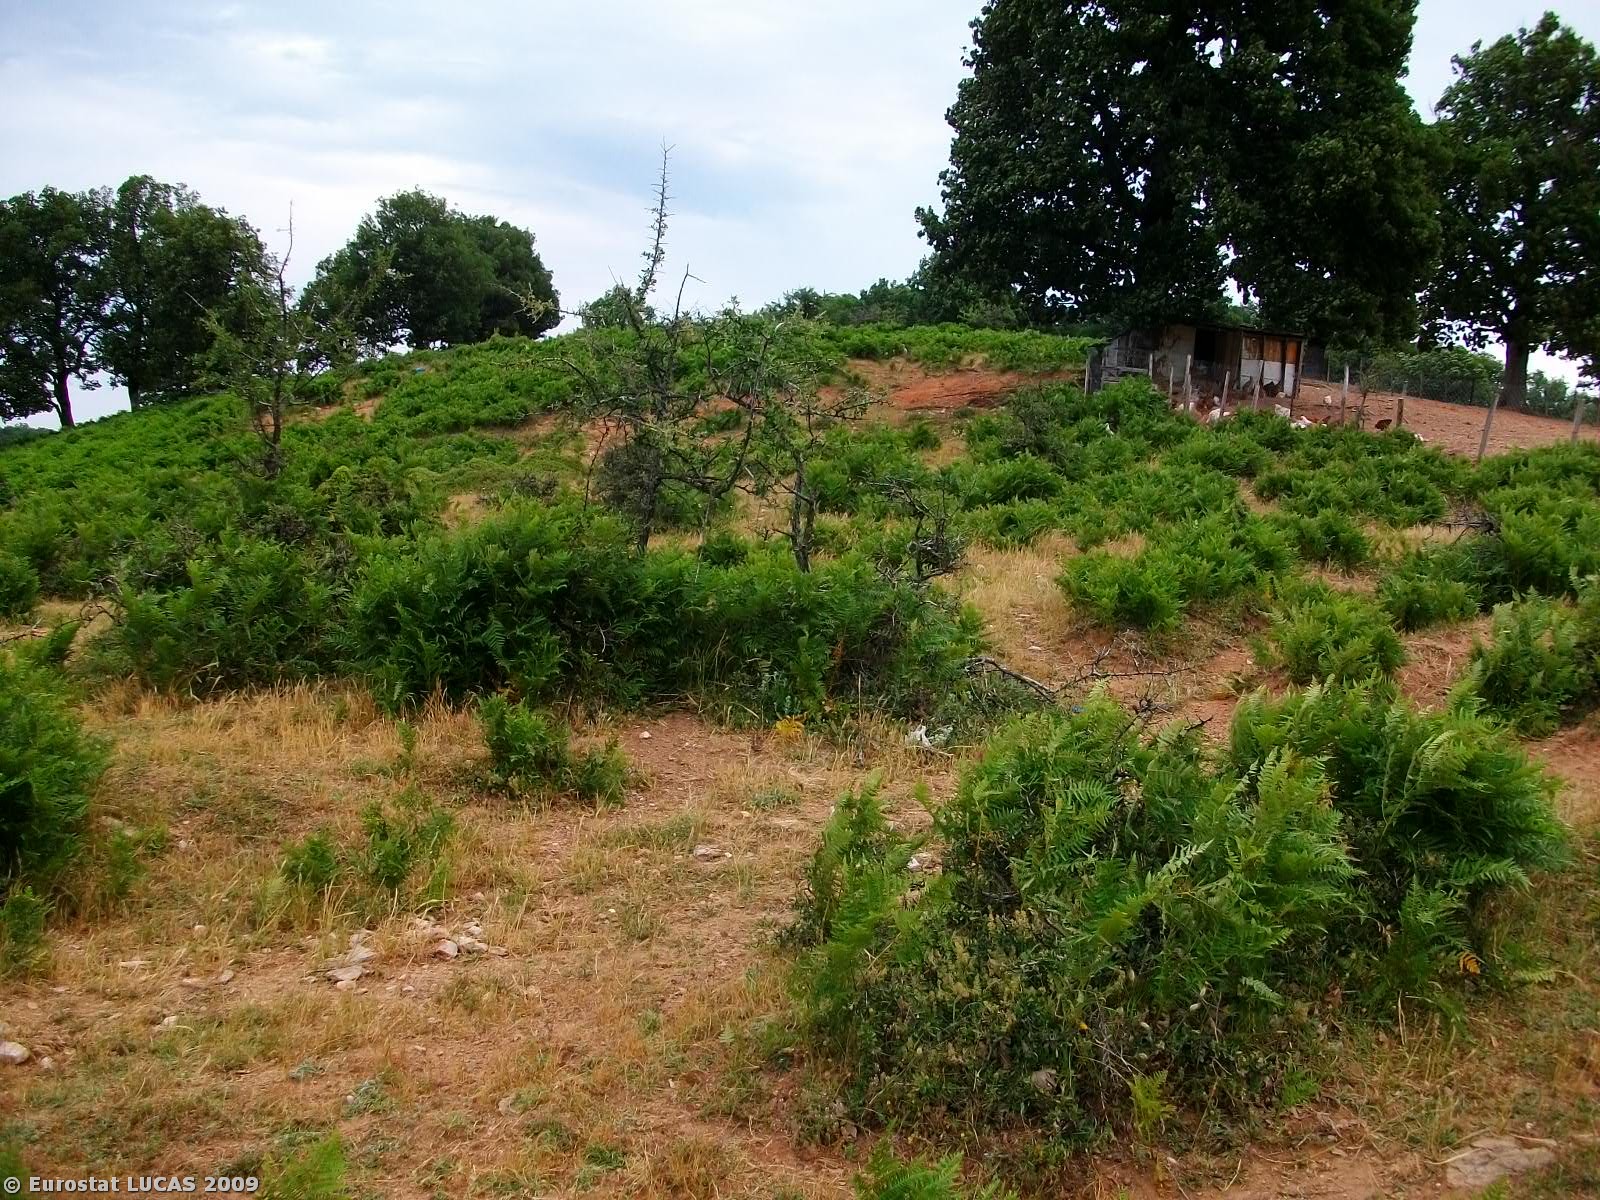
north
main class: Grassland
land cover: Grassland with sparse tree/shrub cover
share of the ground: > 75 %
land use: Agriculture (excluding fallow land and kitchen gardens)
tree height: > 5 m
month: June
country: GR
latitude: 39.5433
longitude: 22.8743
